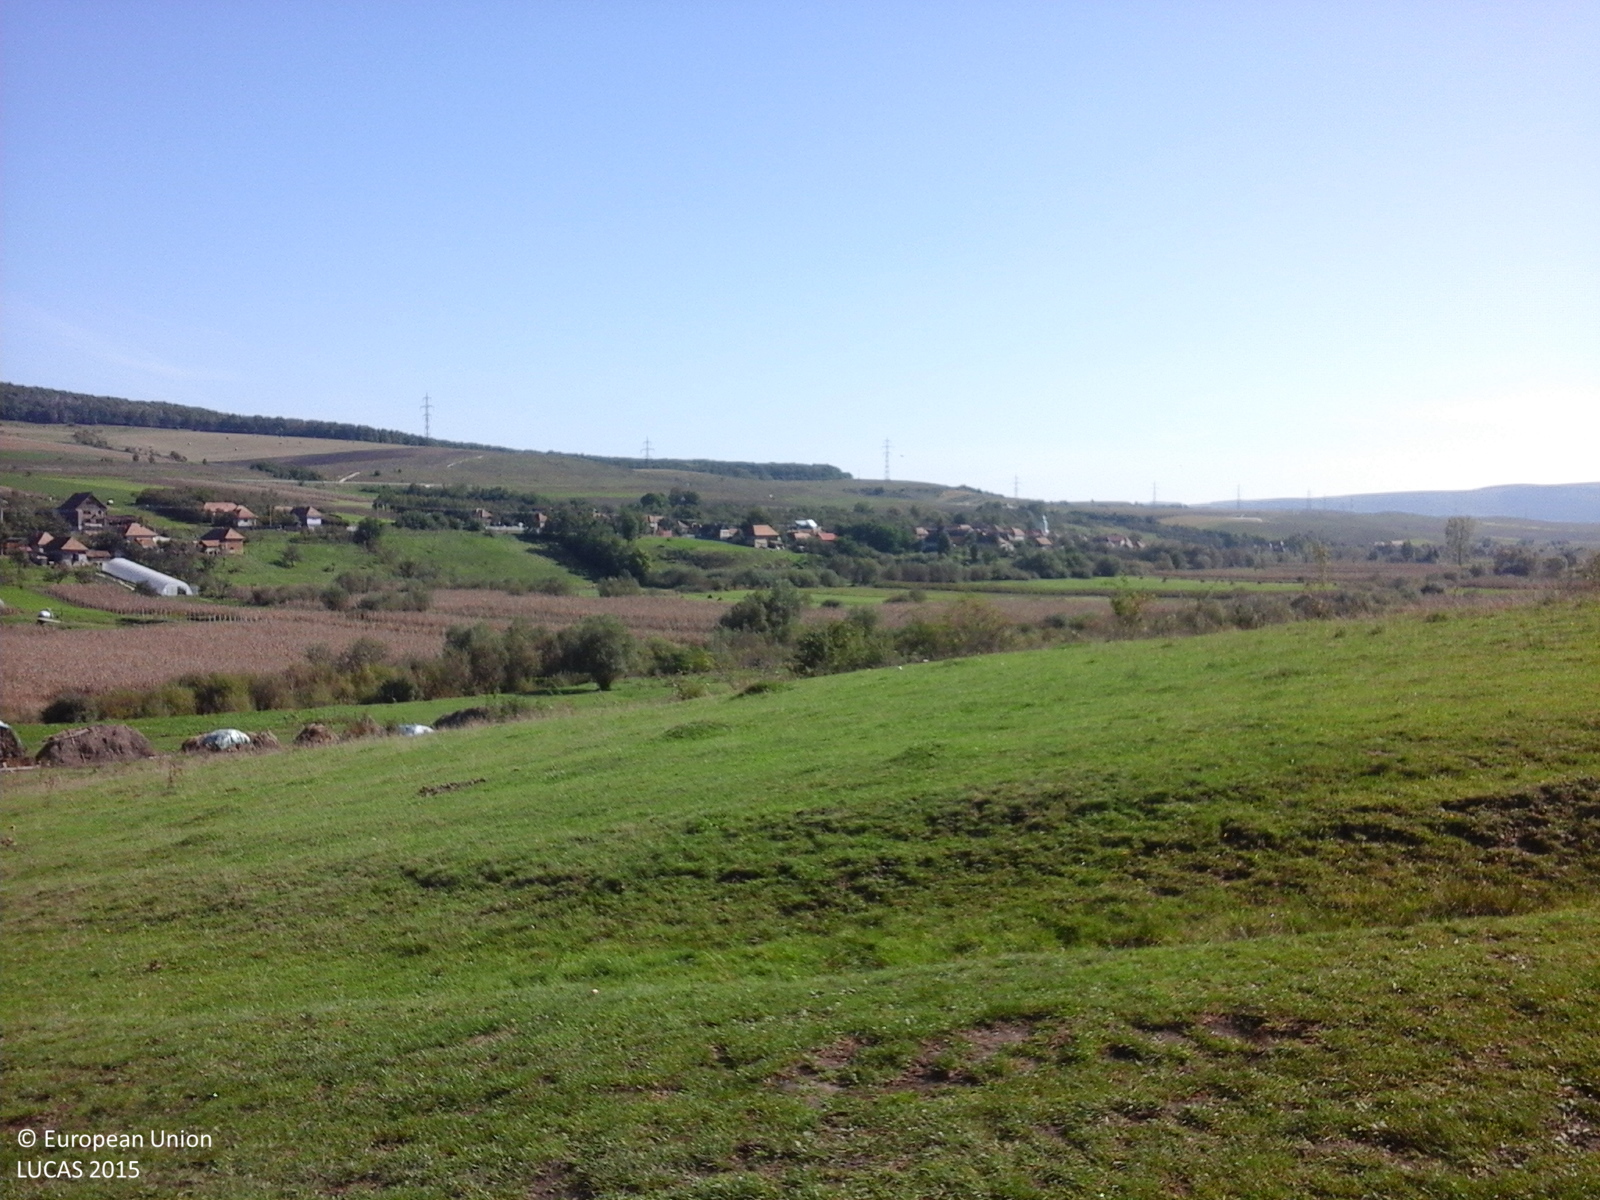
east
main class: Grassland
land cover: Grassland without tree/shrub cover
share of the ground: > 75 %
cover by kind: herbaceous plants 100 %
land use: Agriculture (excluding fallow land and kitchen gardens)
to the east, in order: Grassland without tree/shrub cover; Tracks; Grassland without tree/shrub cover; Ditches and canals; Grassland without tree/shrub cover; Grassland with sparse tree/shrub cover; Spontaneously vegetated surfaces; Grassland with sparse tree/shrub cover; Tracks; Grassland without tree/shrub cover; Spontaneously vegetated surfaces; Inland fresh running water; Spontaneously vegetated surfaces; Maize
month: October
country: RO
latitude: 46.6115
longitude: 23.5838
